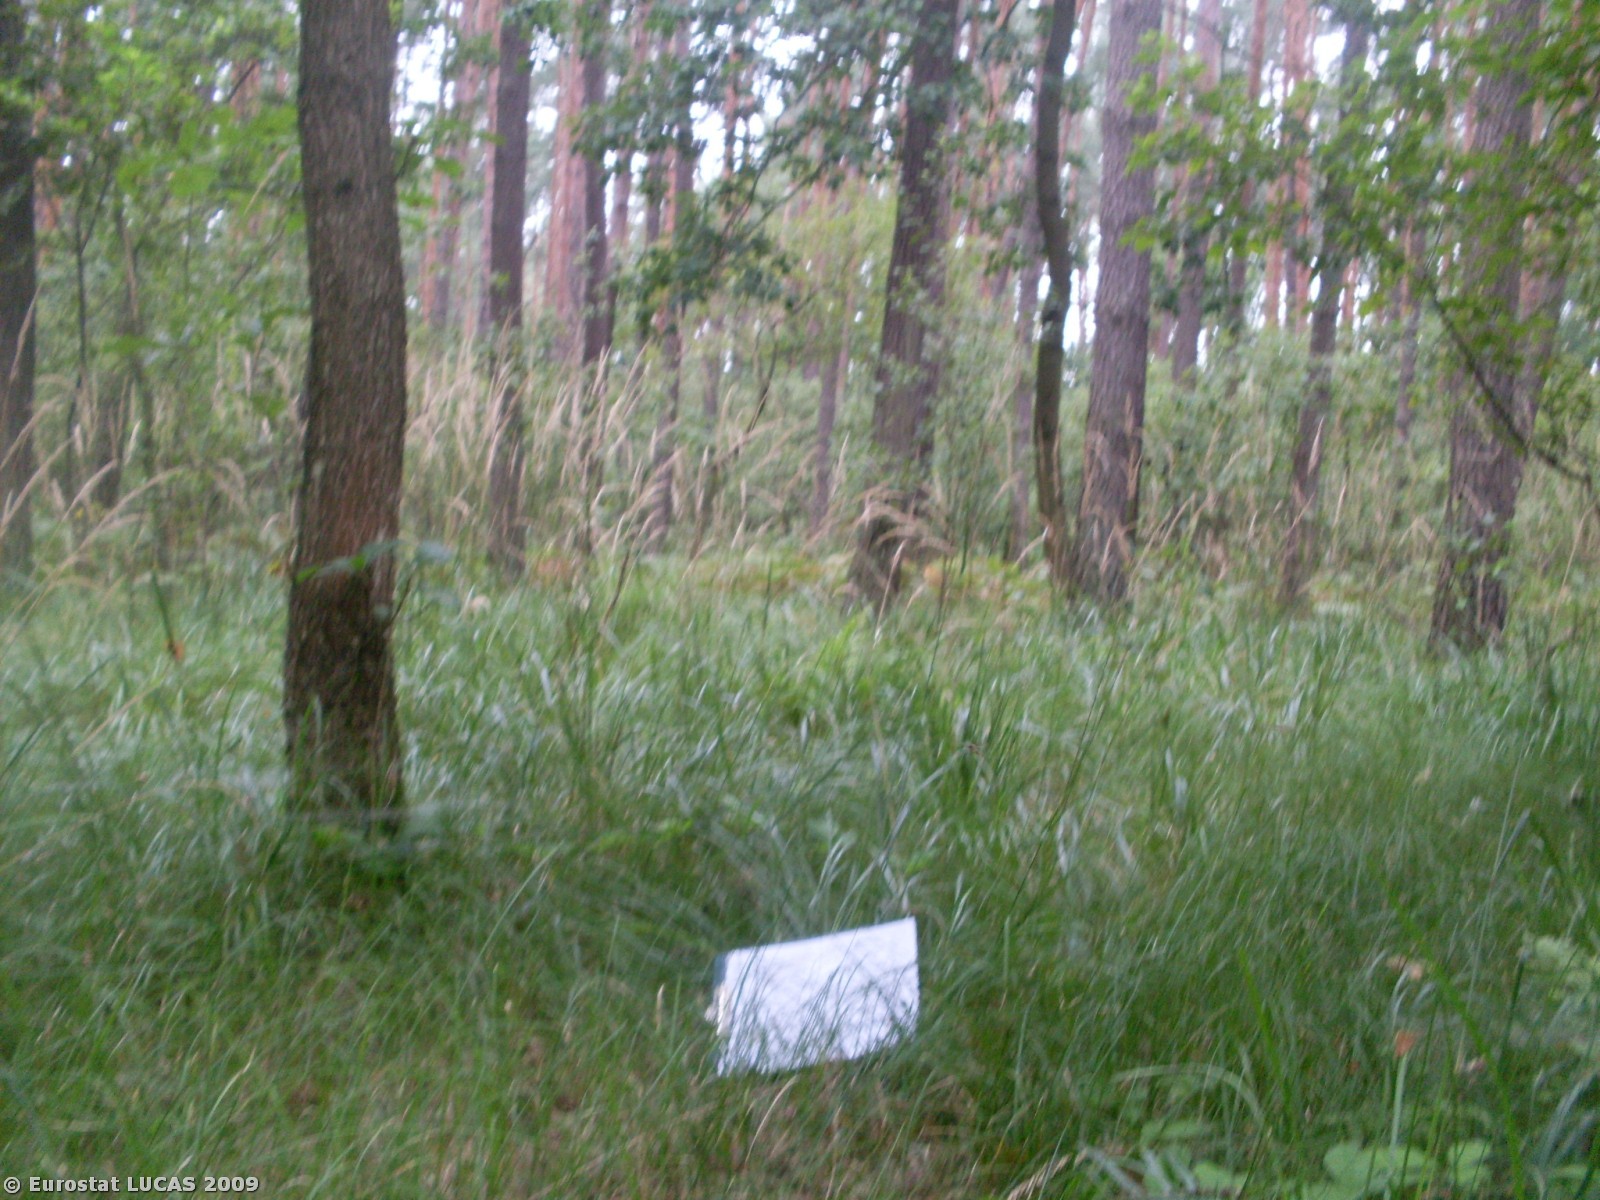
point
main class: Woodland
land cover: Coniferous woodland
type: hemiboreal forest and nemoral coniferous forest and mixed broadleaved-coniferous forest
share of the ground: > 75 %
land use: Forestry
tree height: > 5 m
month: August
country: PL
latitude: 50.0682
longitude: 20.6150
